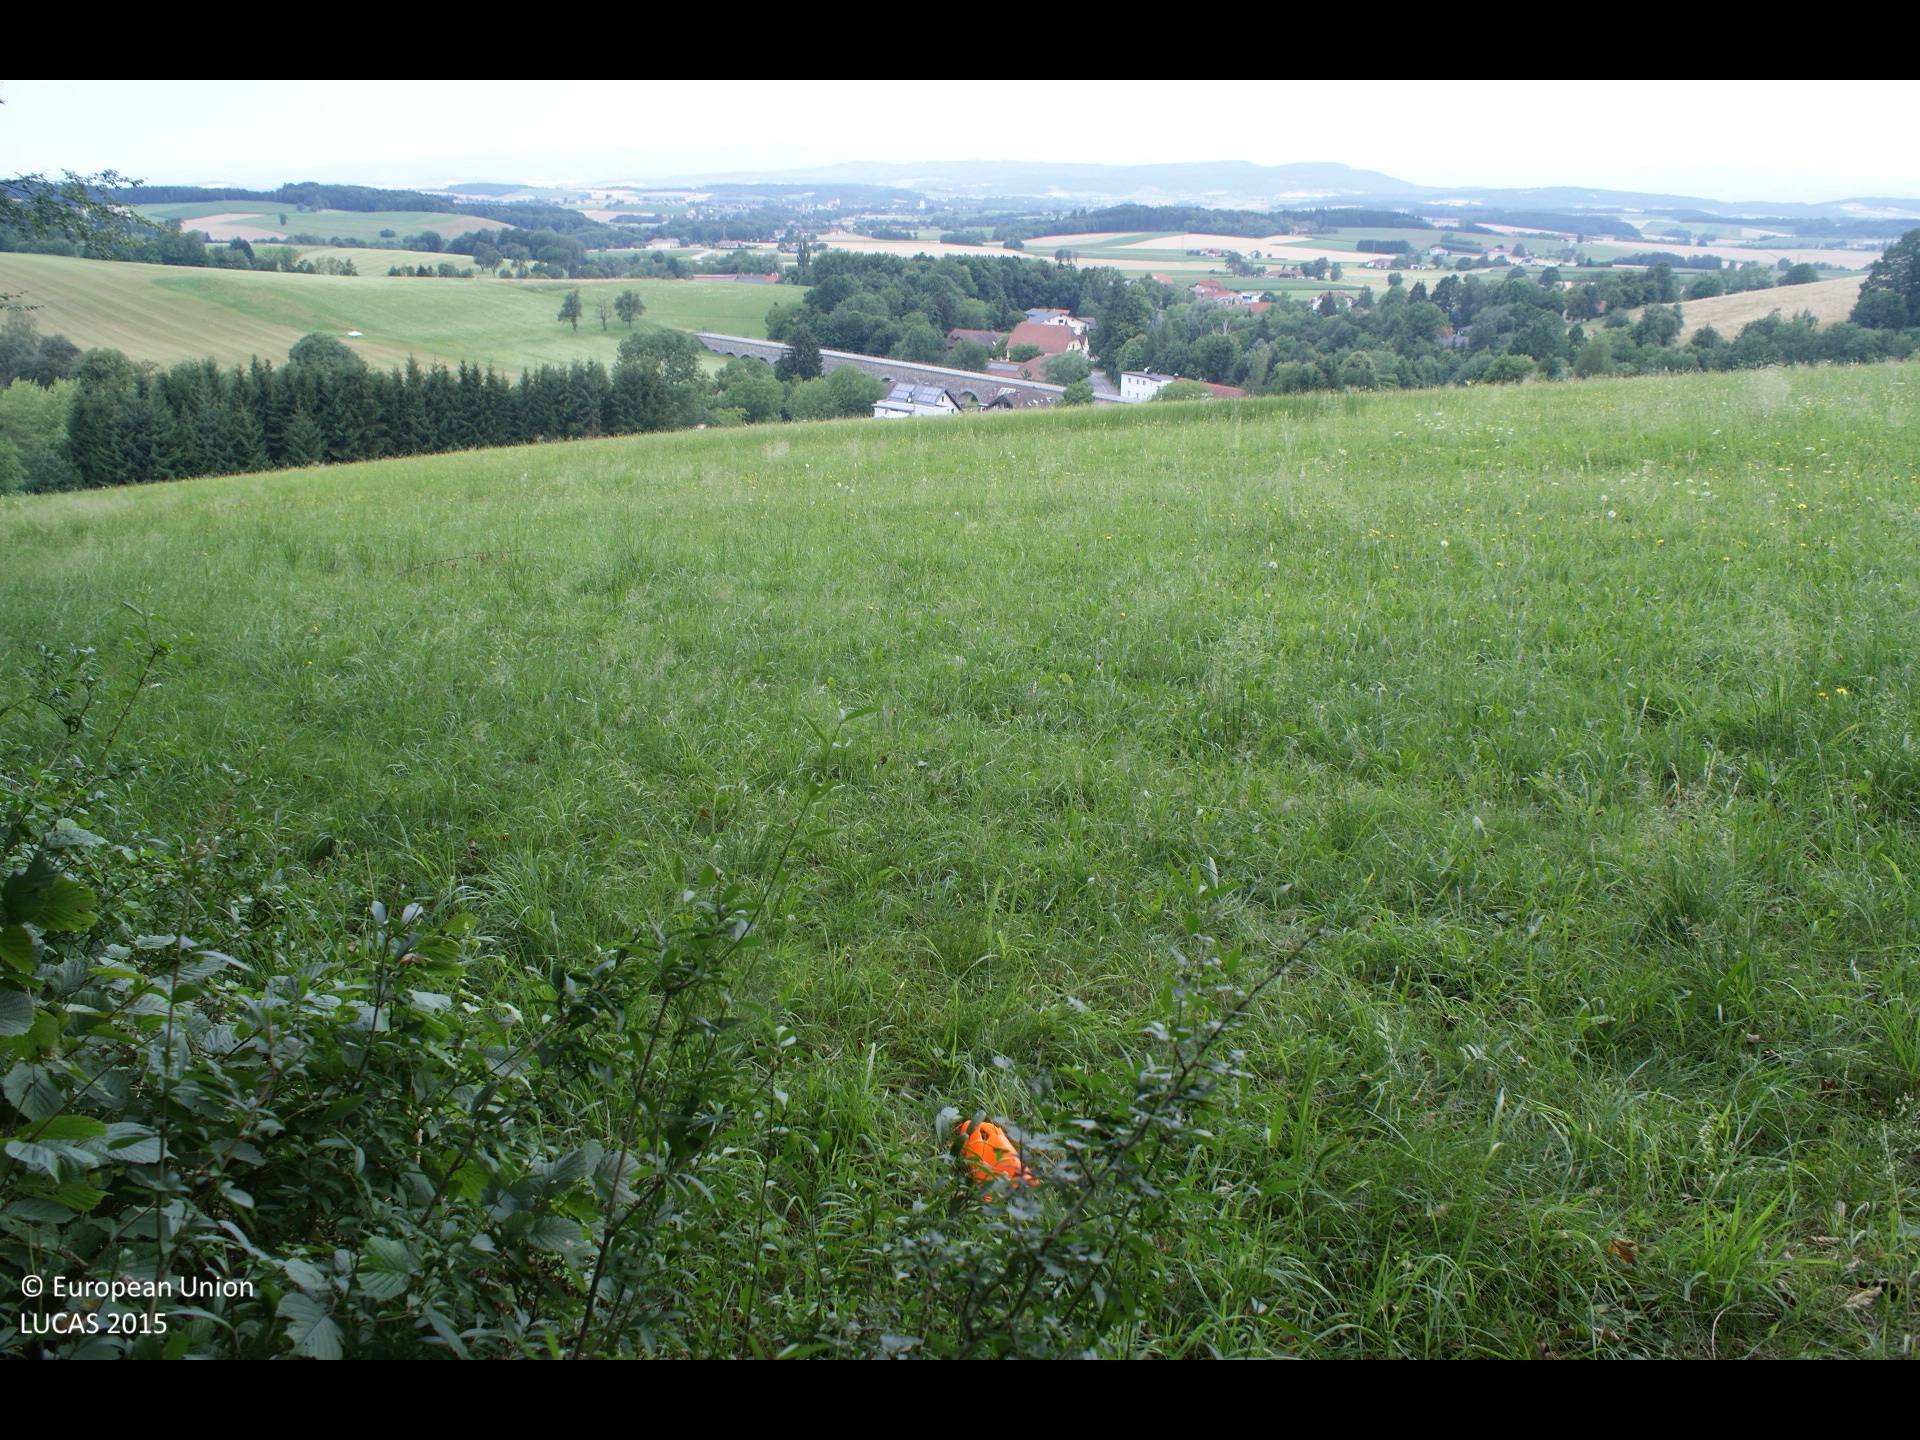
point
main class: Grassland
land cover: Grassland without tree/shrub cover
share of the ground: > 75 %
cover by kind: herbaceous plants 100 %
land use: Agriculture (excluding fallow land and kitchen gardens)
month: July
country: AT
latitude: 48.0740
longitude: 15.3839
